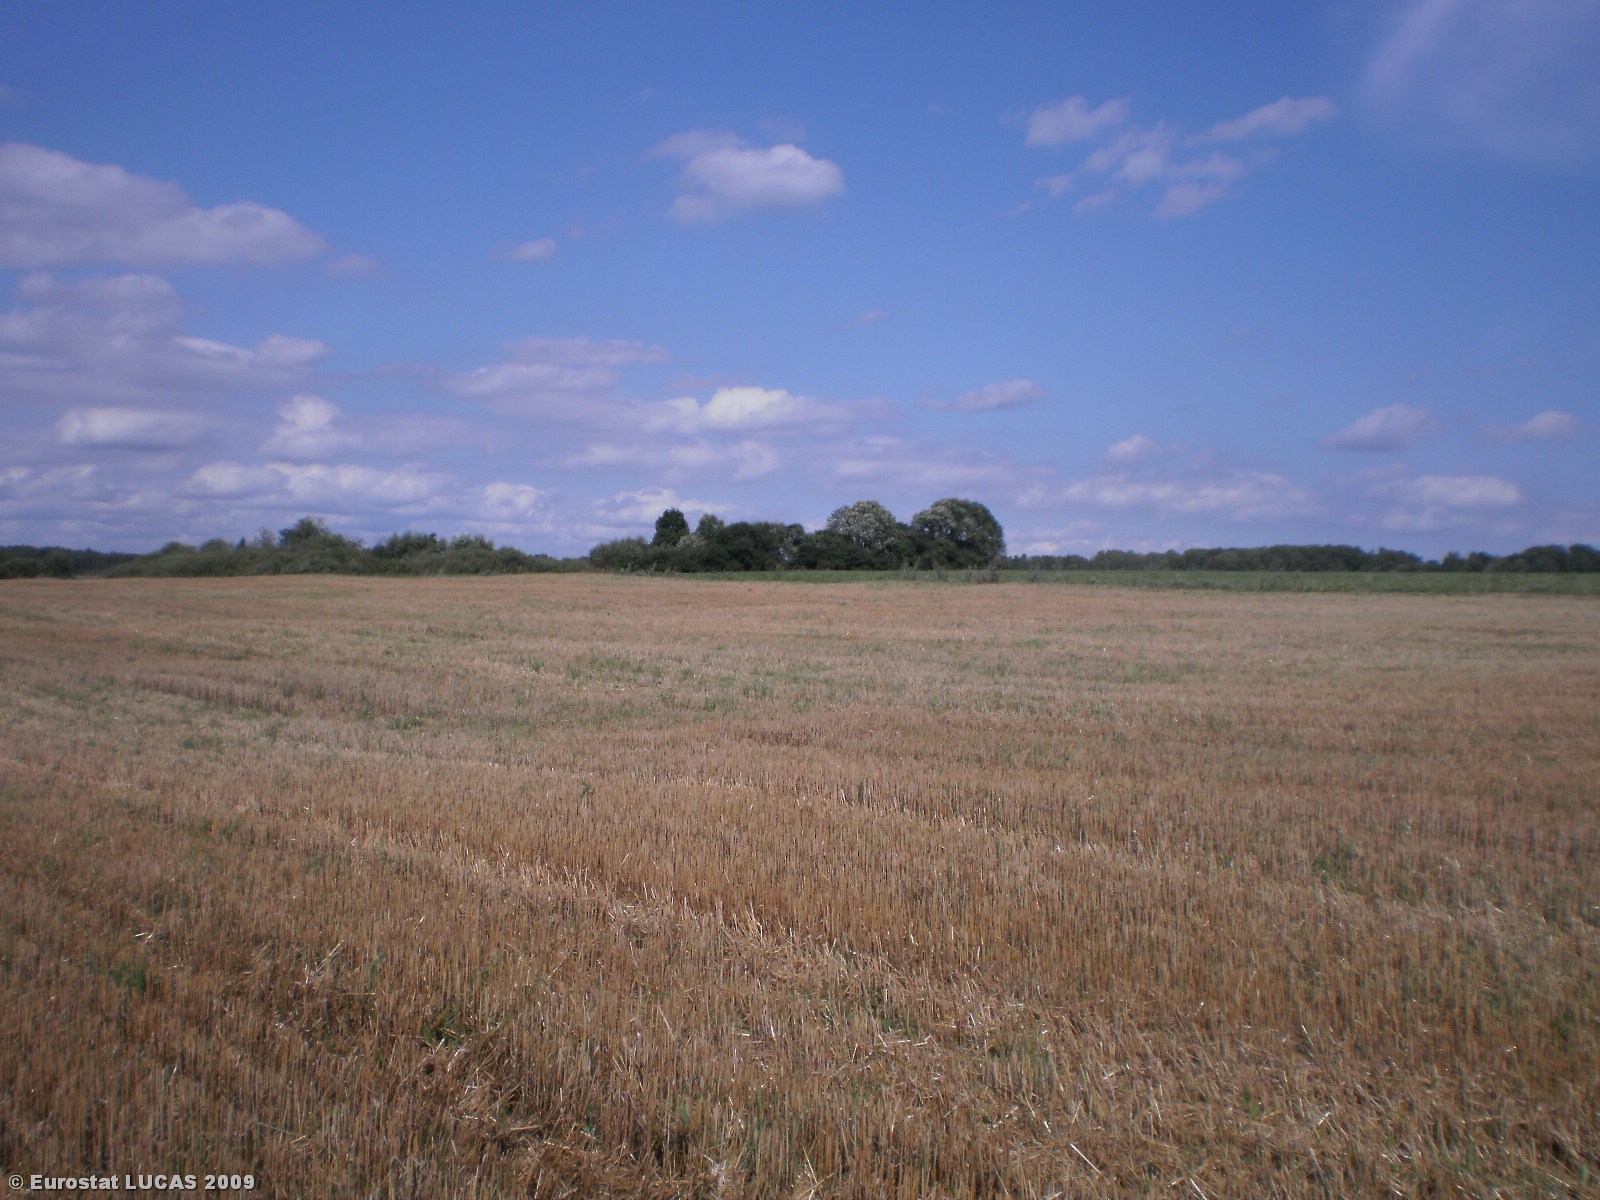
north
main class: Cropland
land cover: Common wheat
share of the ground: < 10 %
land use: Agriculture (excluding fallow land and kitchen gardens)
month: August
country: LT
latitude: 55.0867
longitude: 24.6275
